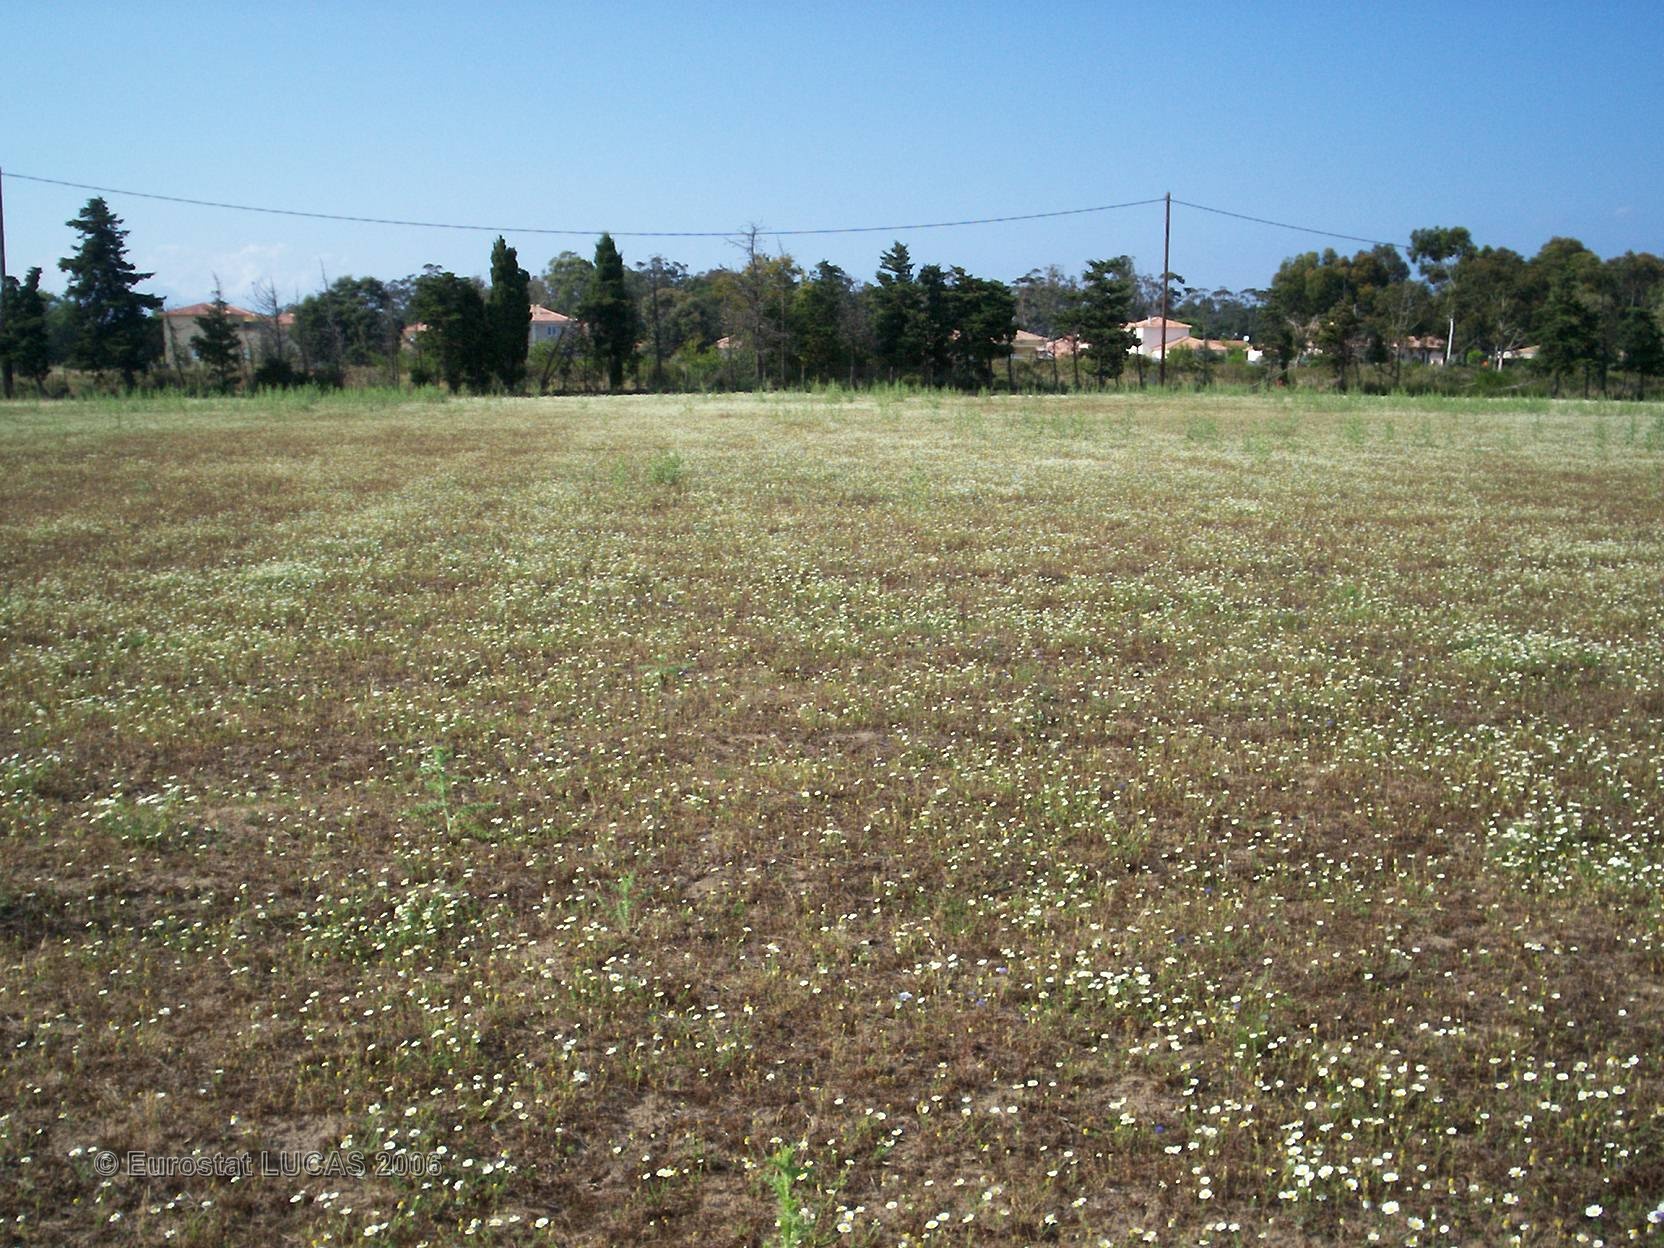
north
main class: Grassland
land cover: Grassland without tree/shrub cover
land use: Agriculture (excluding fallow land and kitchen gardens)
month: June
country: FR
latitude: 42.5445
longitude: 9.5267
